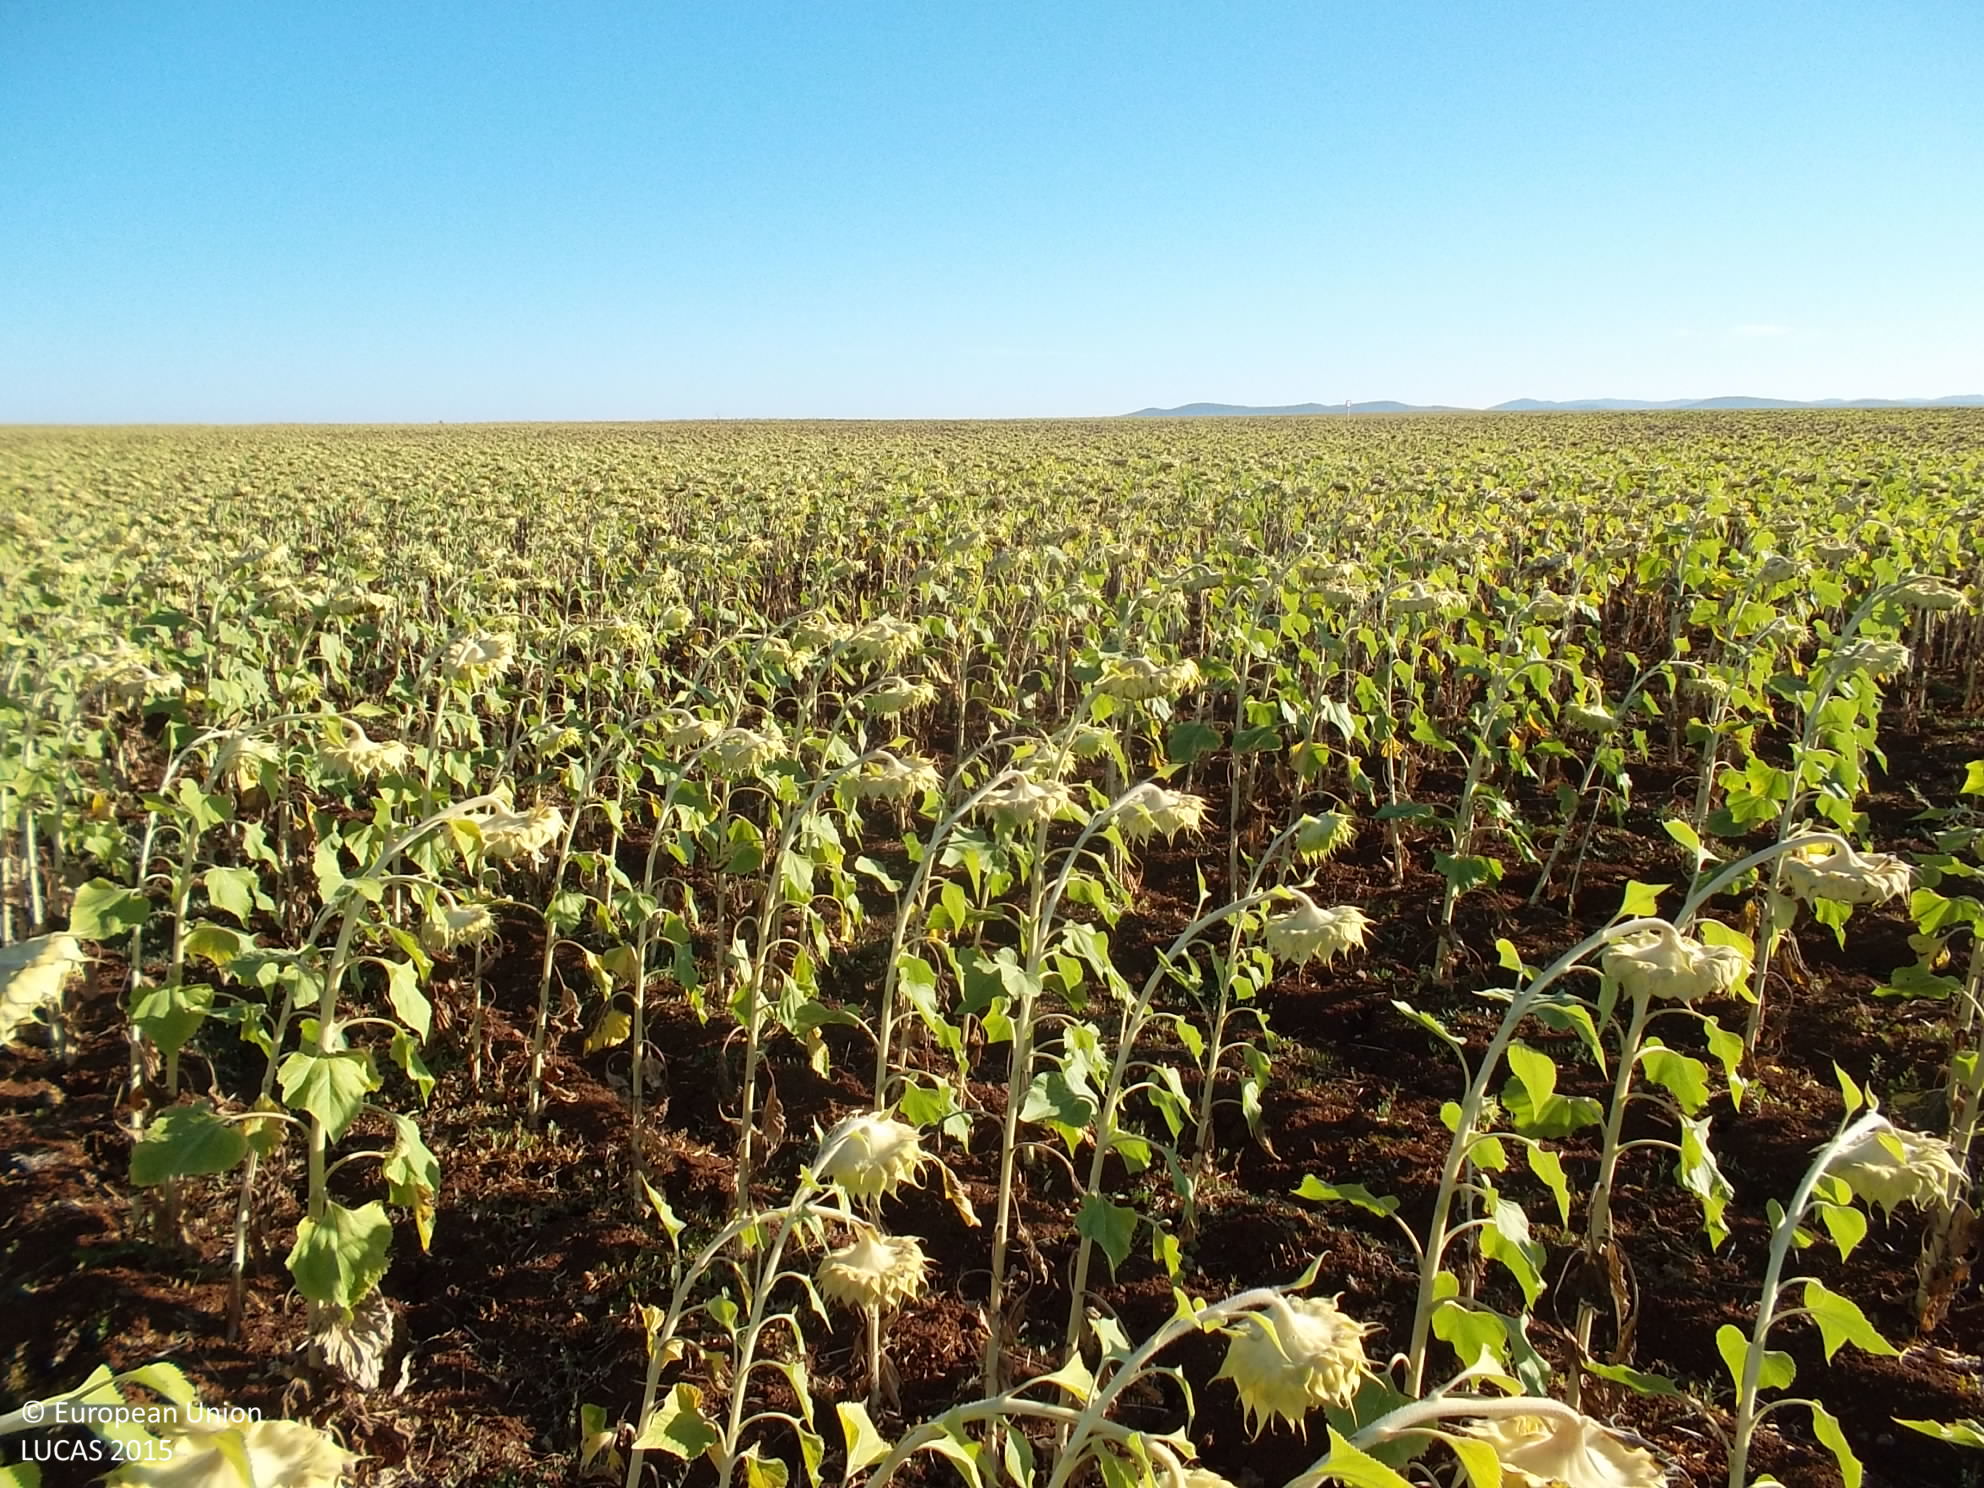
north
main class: Cropland
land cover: Sunflower
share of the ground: > 75 %
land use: Agriculture (excluding fallow land and kitchen gardens)
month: July
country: ES
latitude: 38.3465
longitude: -5.7236
